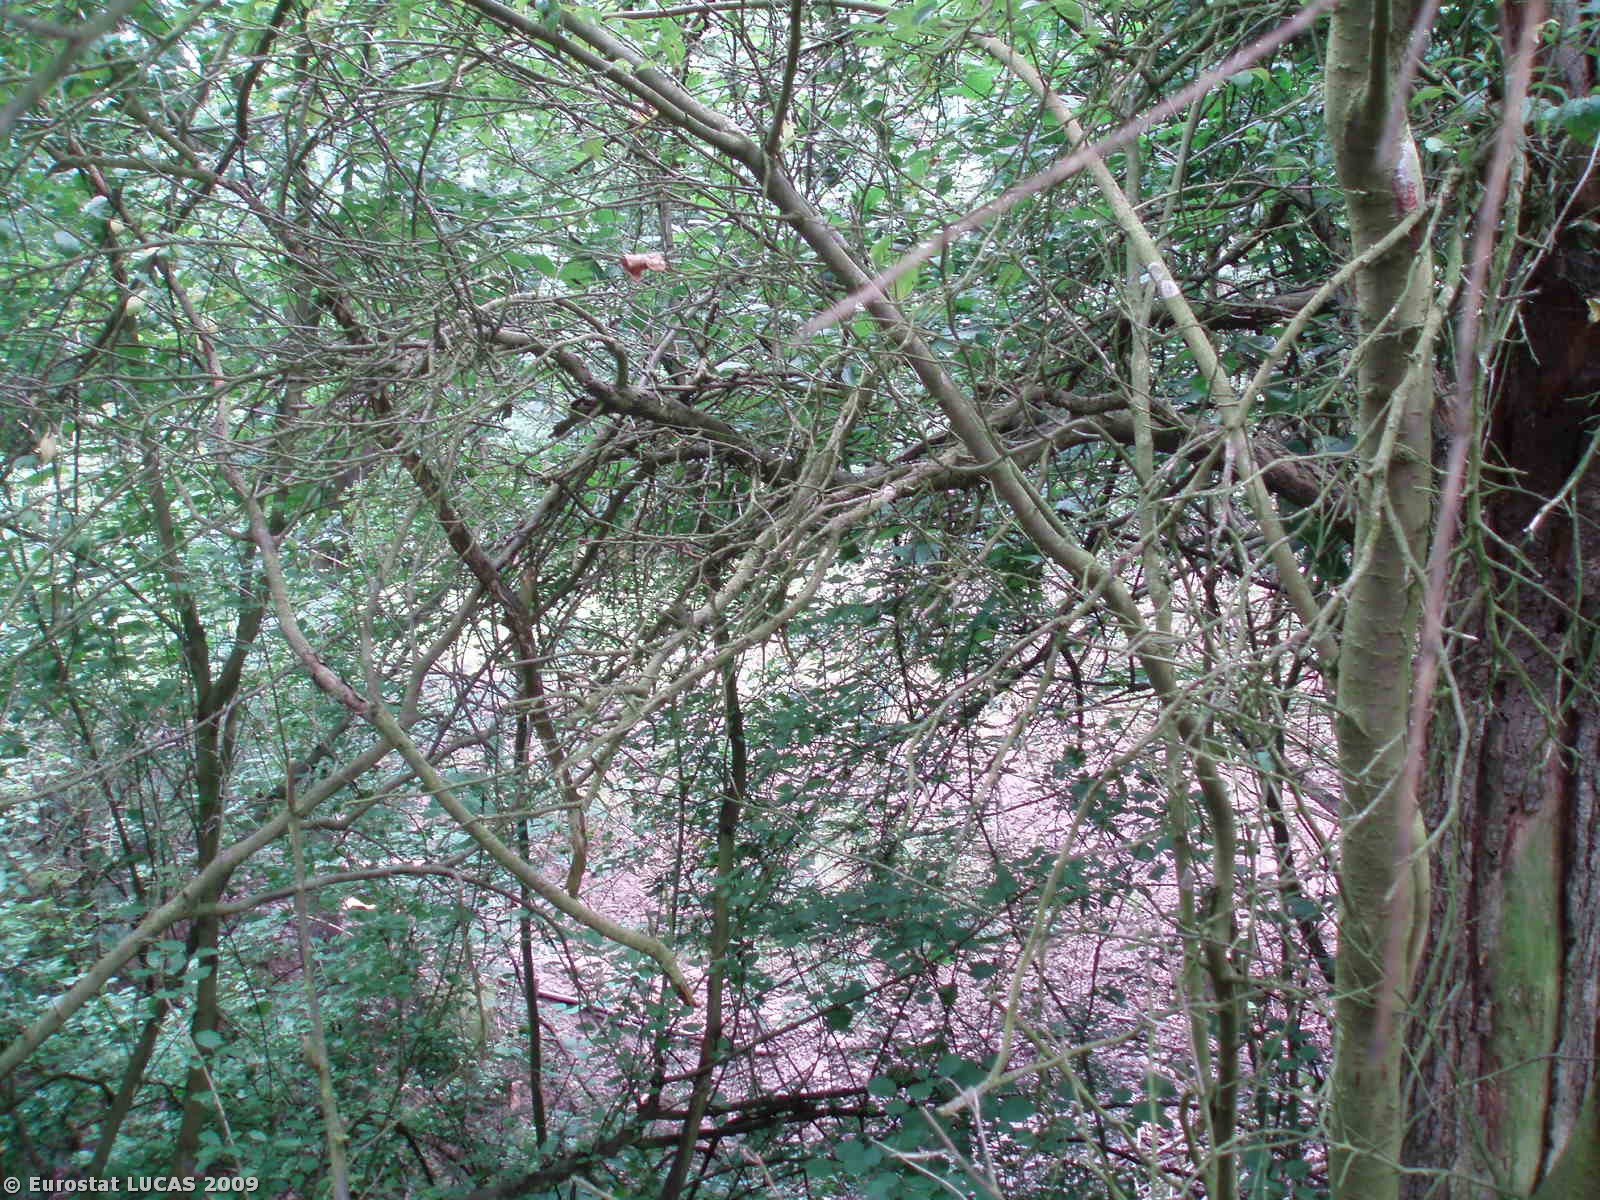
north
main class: Woodland
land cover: Broadleaved woodland
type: mesophytic deciduous forest
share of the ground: > 75 %
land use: Forestry
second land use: Nature reserves
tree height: > 5 m
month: July
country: CZ
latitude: 50.7009
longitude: 14.2064
